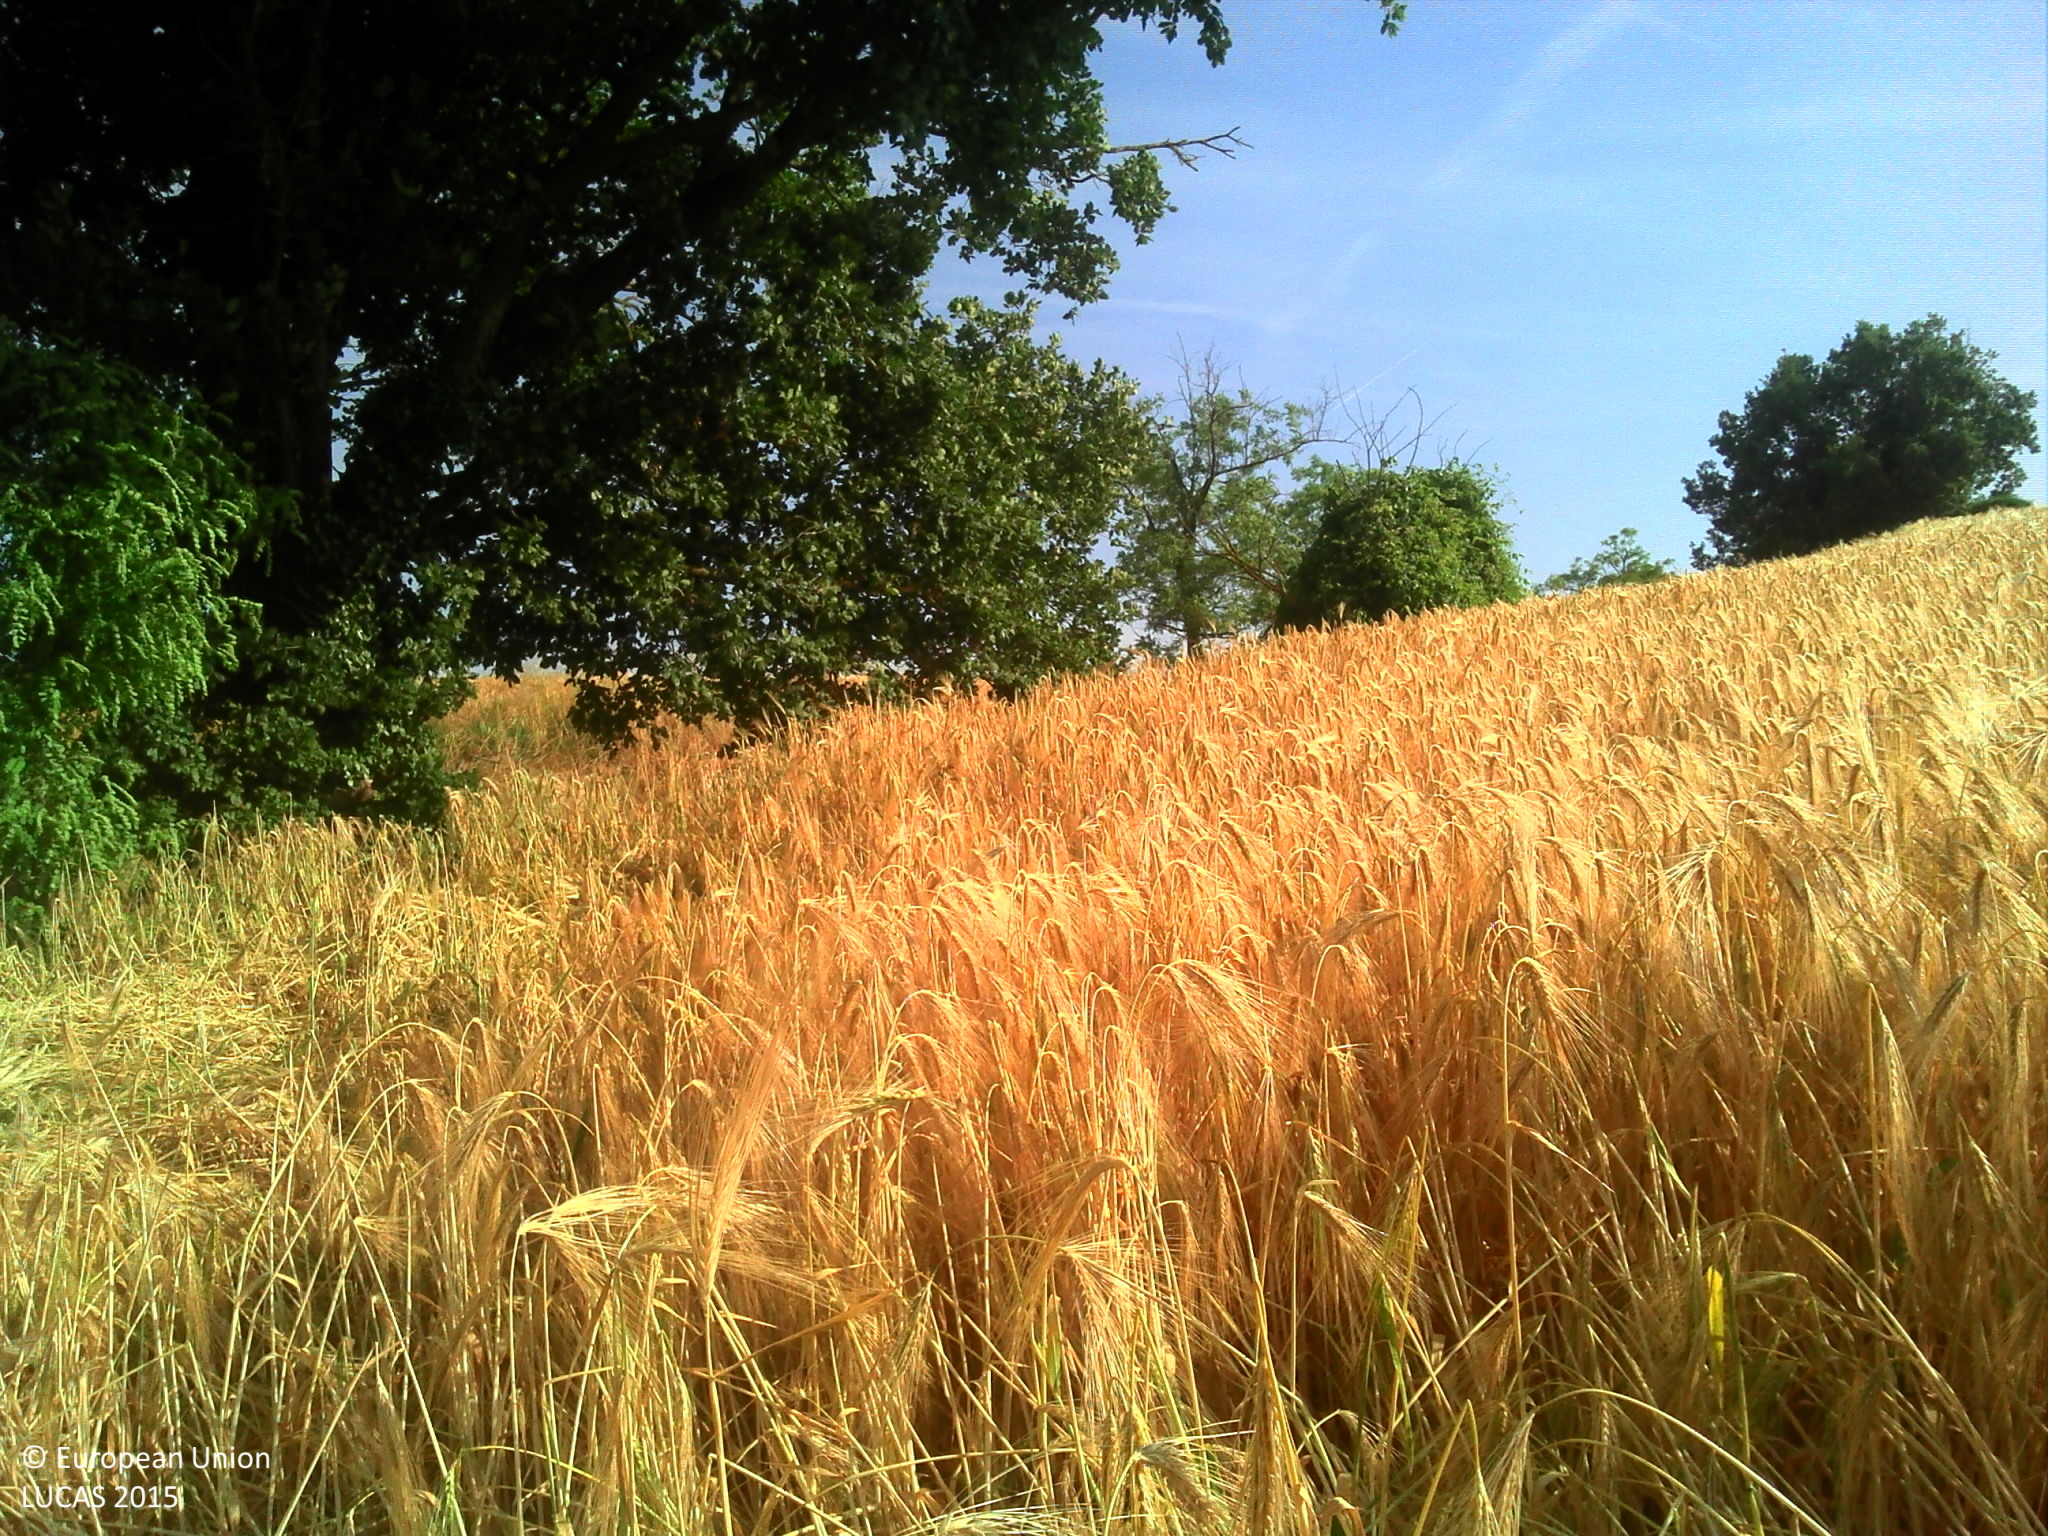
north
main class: Cropland
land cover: Barley
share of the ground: > 75 %
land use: Agriculture (excluding fallow land and kitchen gardens)
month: June
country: FR
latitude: 43.6398
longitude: 1.7355
